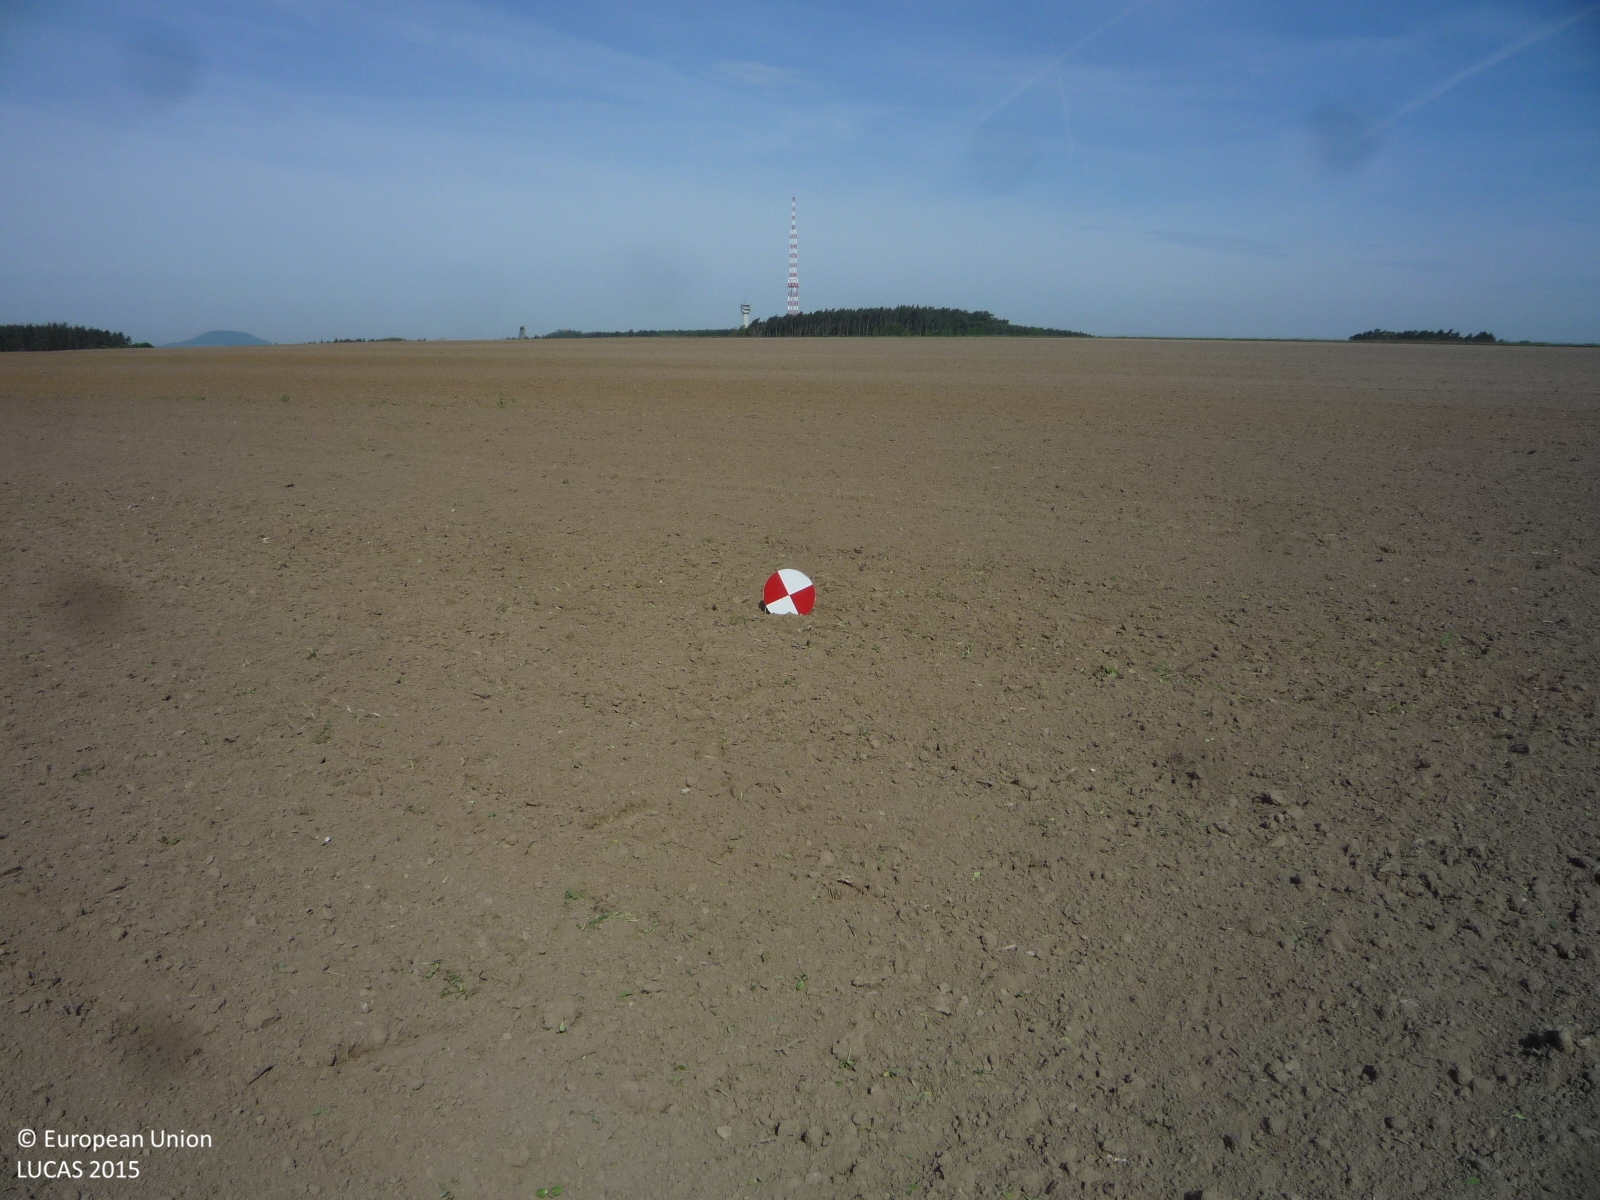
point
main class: Cropland
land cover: Dry pulses
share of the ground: < 10 %
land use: Agriculture (excluding fallow land and kitchen gardens)
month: May
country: CZ
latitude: 50.3639
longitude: 14.5425
